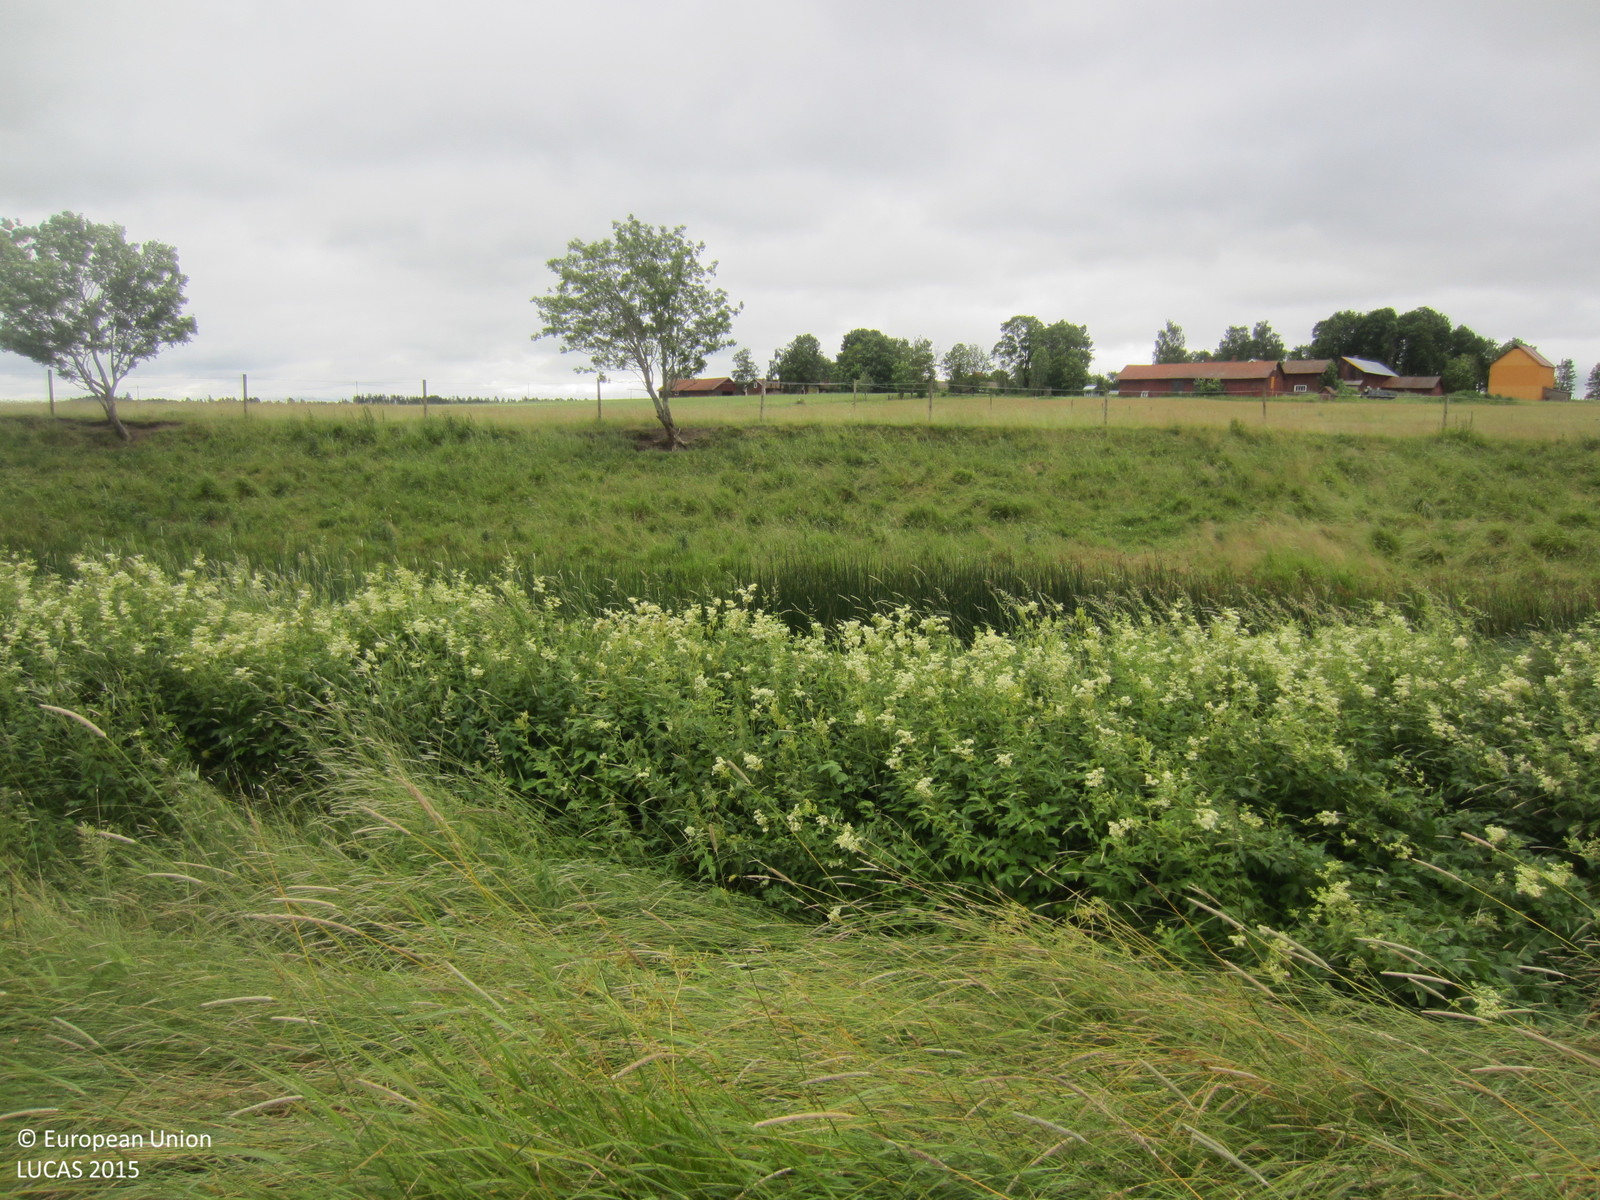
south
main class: Grassland
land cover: Grassland without tree/shrub cover
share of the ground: > 75 %
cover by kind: herbaceous plants 100 %
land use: Agriculture (excluding fallow land and kitchen gardens)
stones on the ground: > 50 %
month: July
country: SE
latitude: 59.7687
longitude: 17.0618
